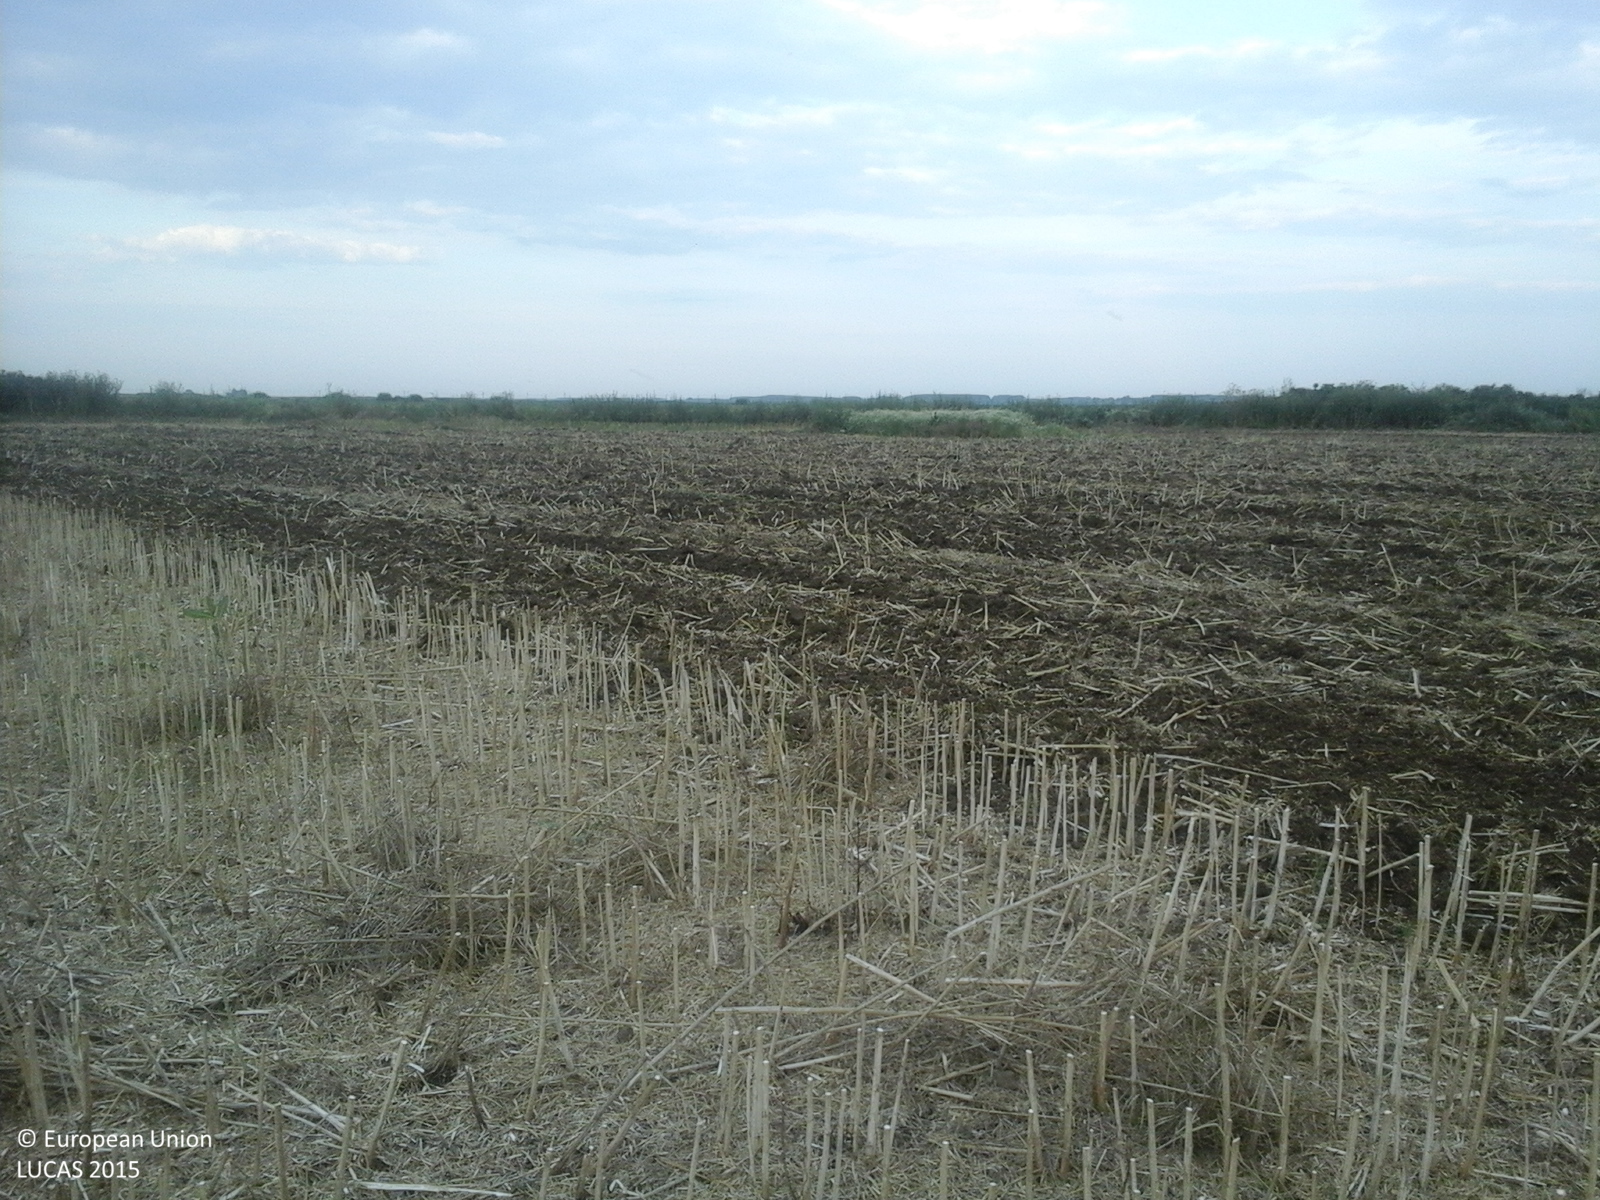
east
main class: Cropland
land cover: Rape and turnip rape
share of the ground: < 10 %
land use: Agriculture (excluding fallow land and kitchen gardens)
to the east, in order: Rape and turnip rape; Shruby margins; Ditches and canals; Shruby margins; Soya
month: June
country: RO
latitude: 44.0112
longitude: 26.1550
